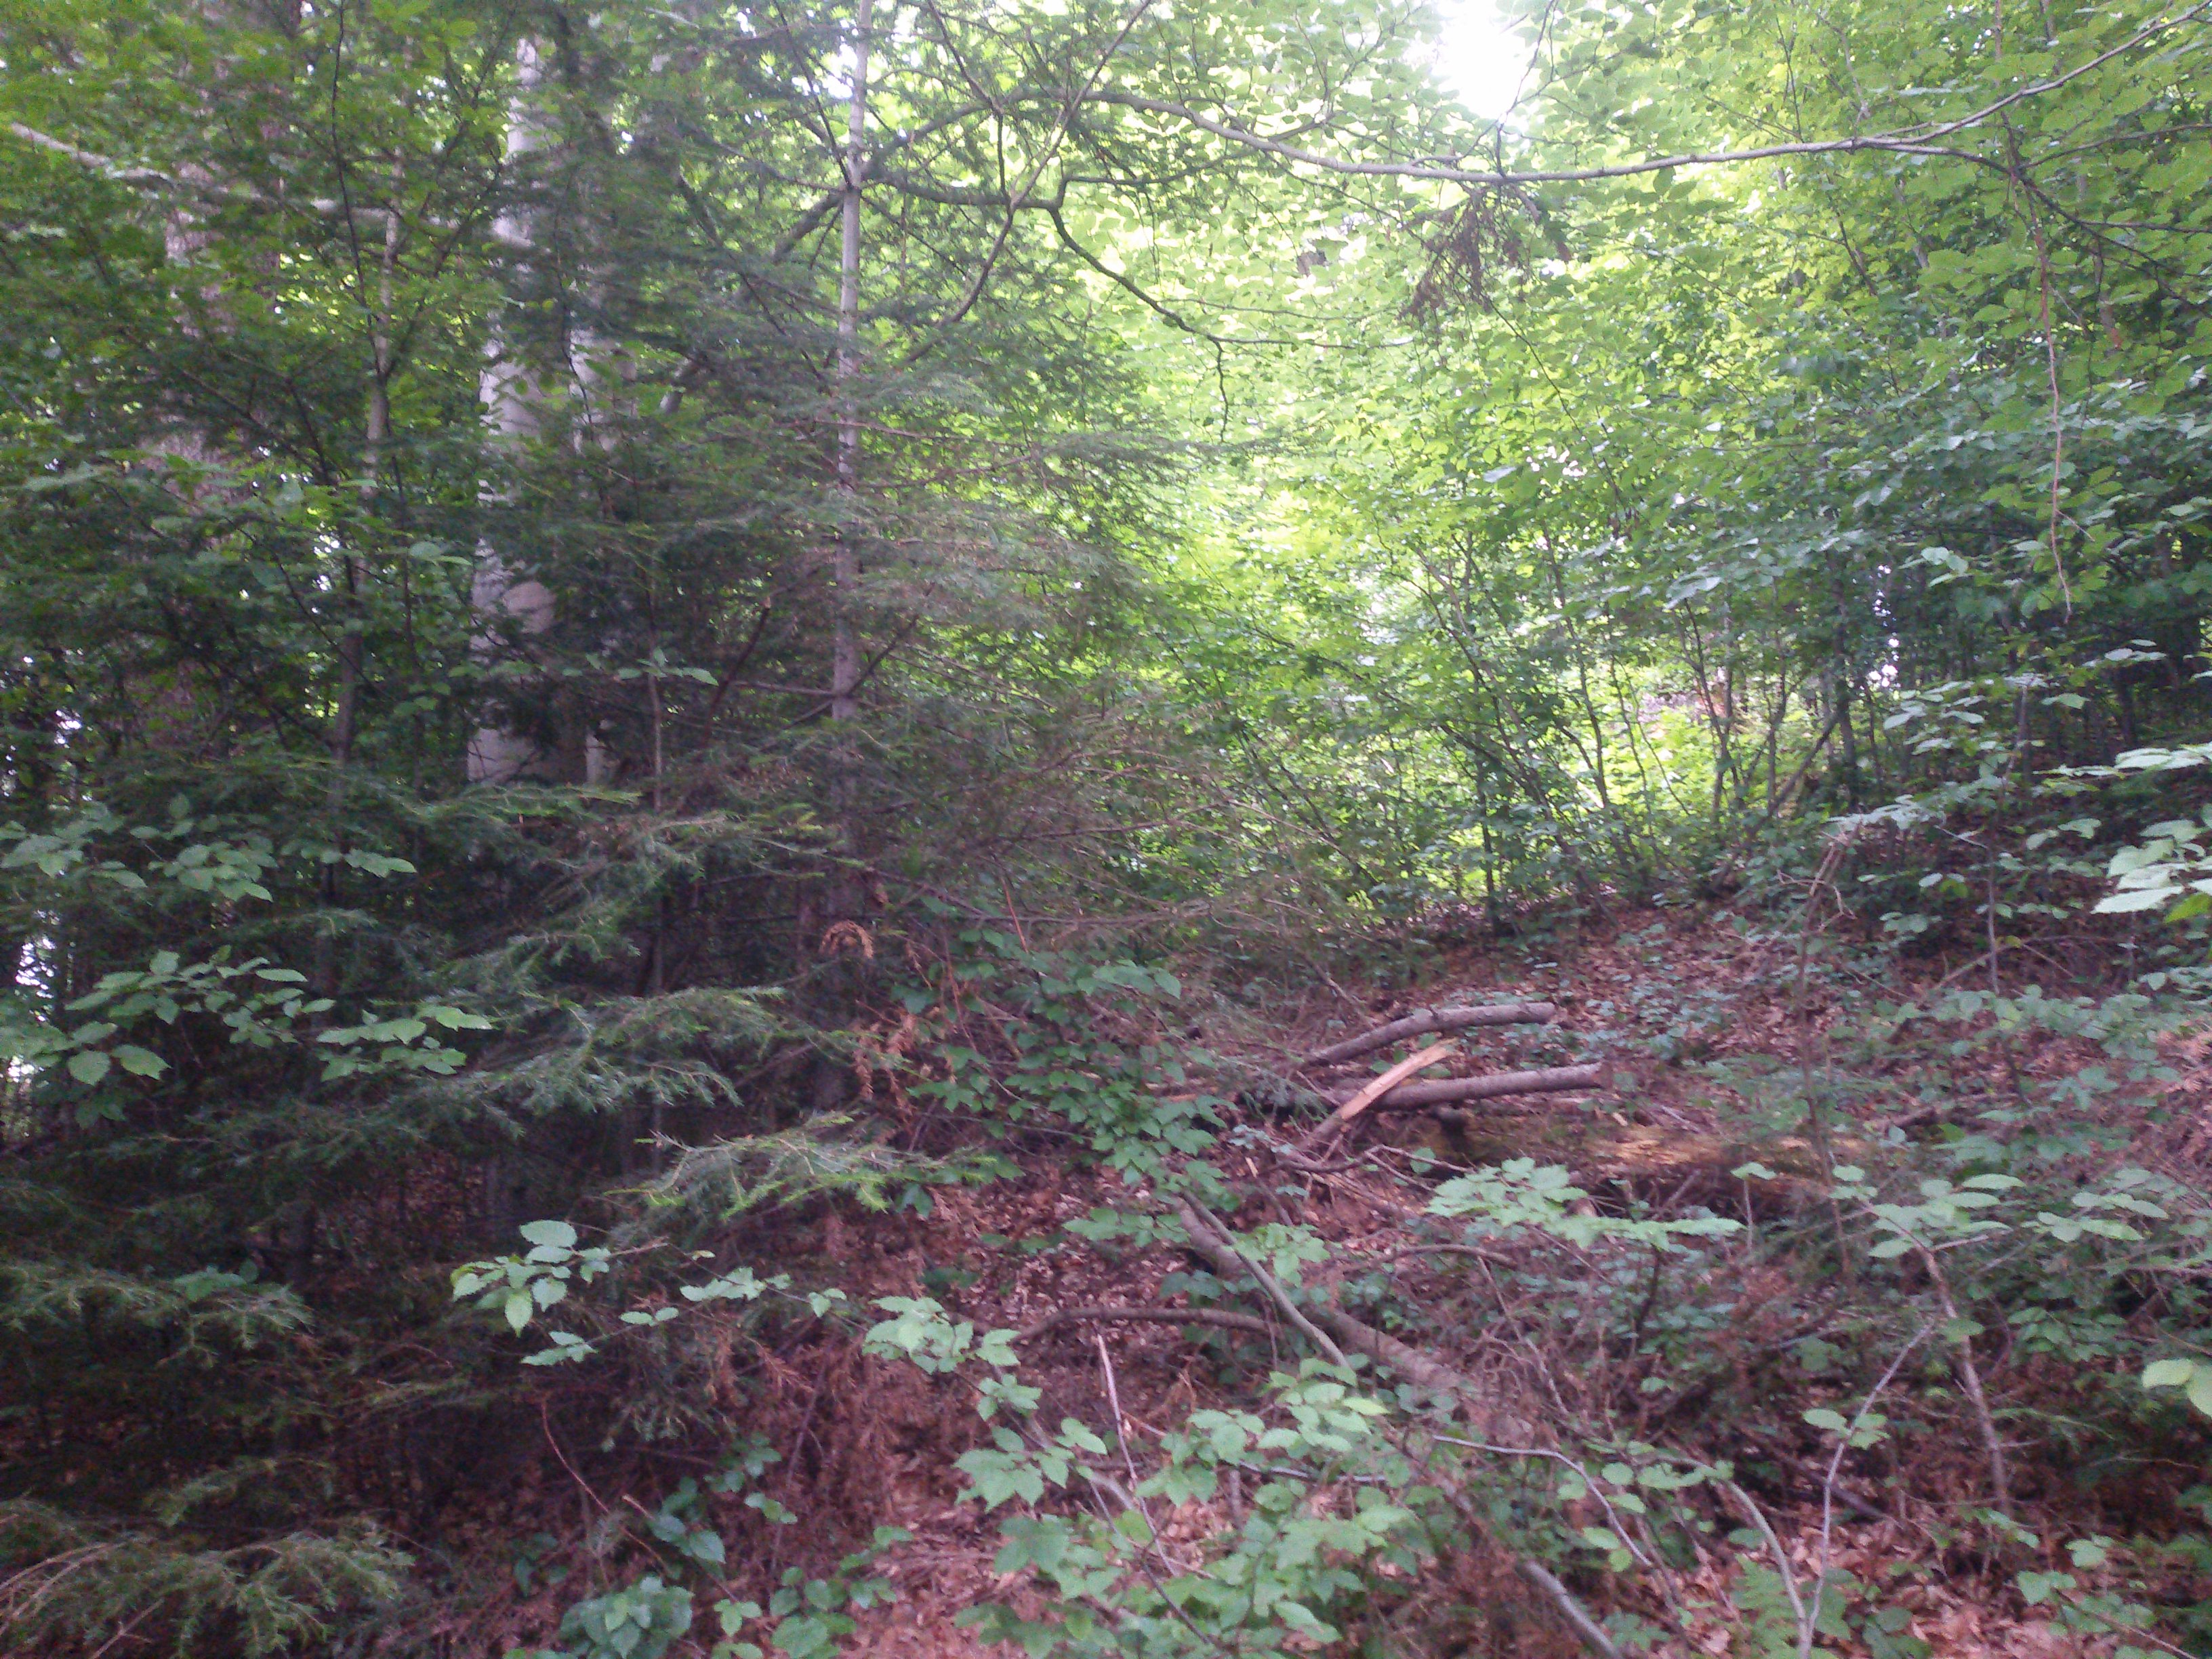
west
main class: Woodland
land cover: Other mixed woodland
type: hemiboreal forest and nemoral coniferous forest and mixed broadleaved-coniferous forest
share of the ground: > 75 %
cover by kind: broadleaved forest trees 50 %, coniferous forest trees 30 %, unconsolidated bare surface 10 %, shrubs 5 %, herbaceous plants 5 %
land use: Forestry
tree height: > 5 m
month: July
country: PL
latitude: 49.7381
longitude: 22.2576
